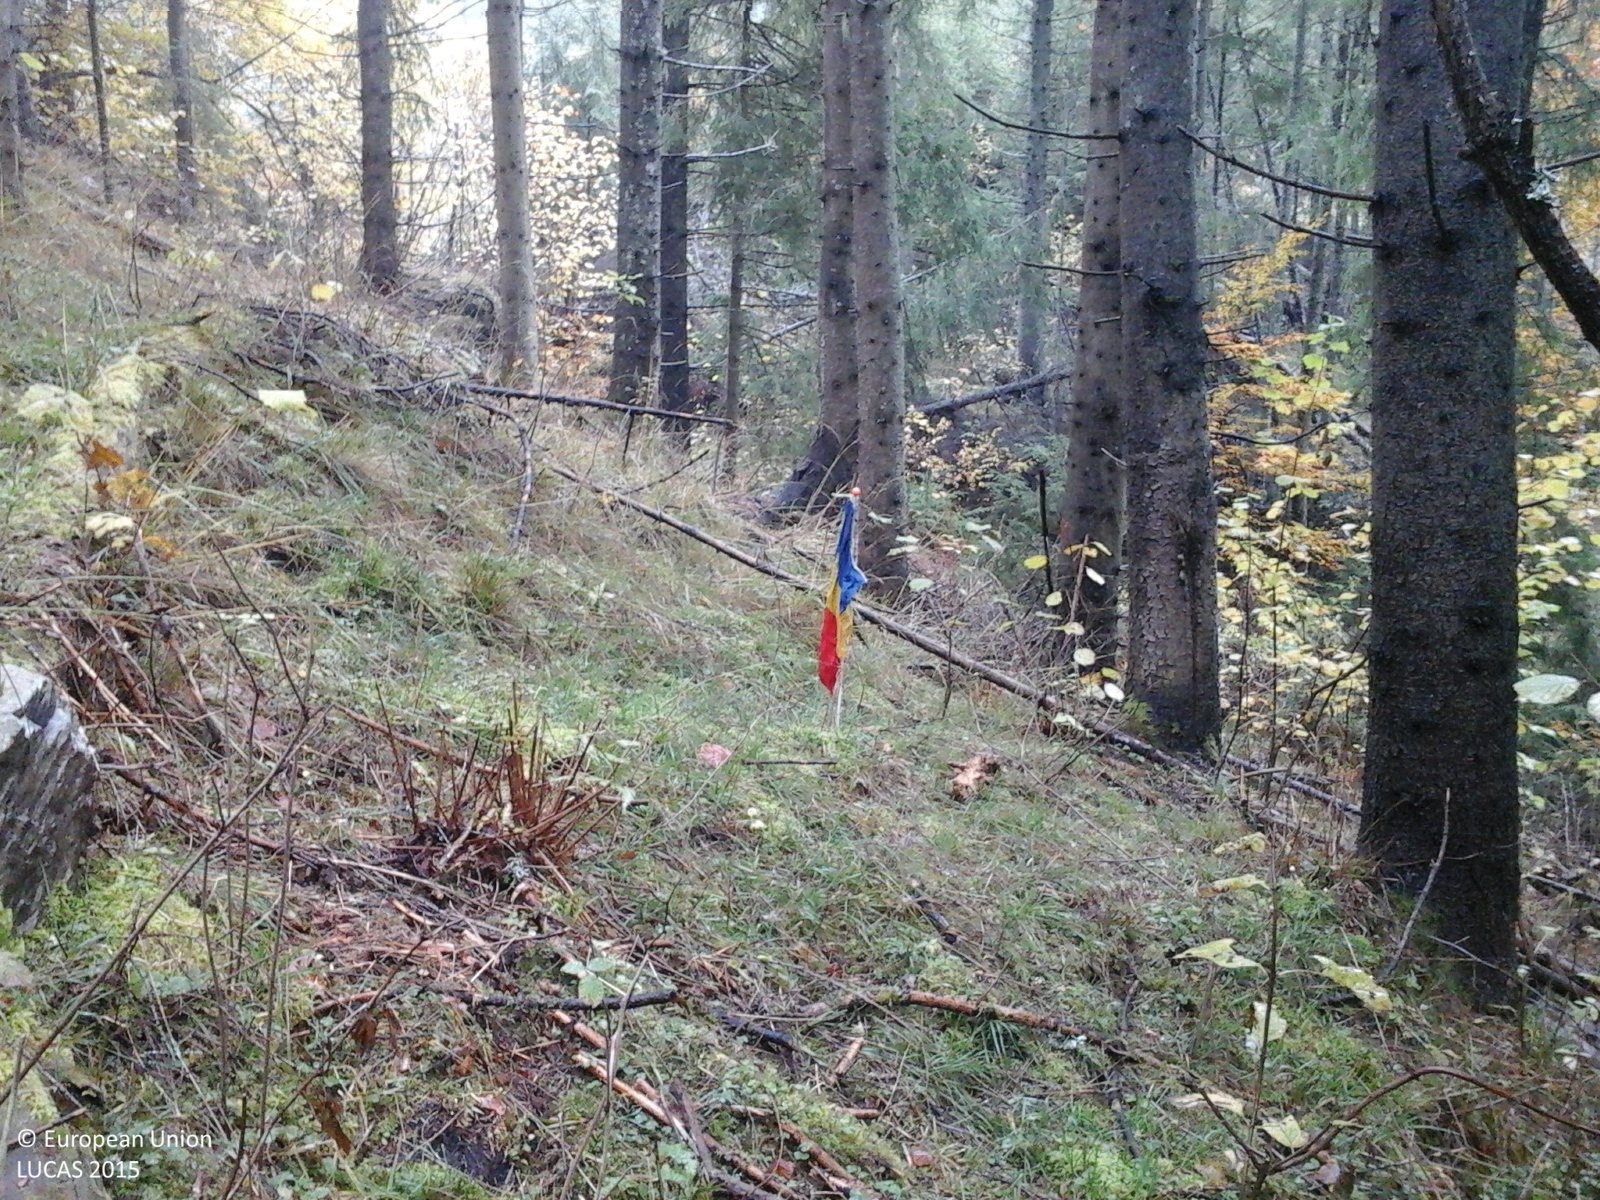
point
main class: Woodland
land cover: Spruce dominated coniferous woodland
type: alpine coniferous forest
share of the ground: > 75 %
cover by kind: coniferous forest trees 100 %
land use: Forestry
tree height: > 5 m
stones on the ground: > 50 %
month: October
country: RO
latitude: 47.0516
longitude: 25.5824
